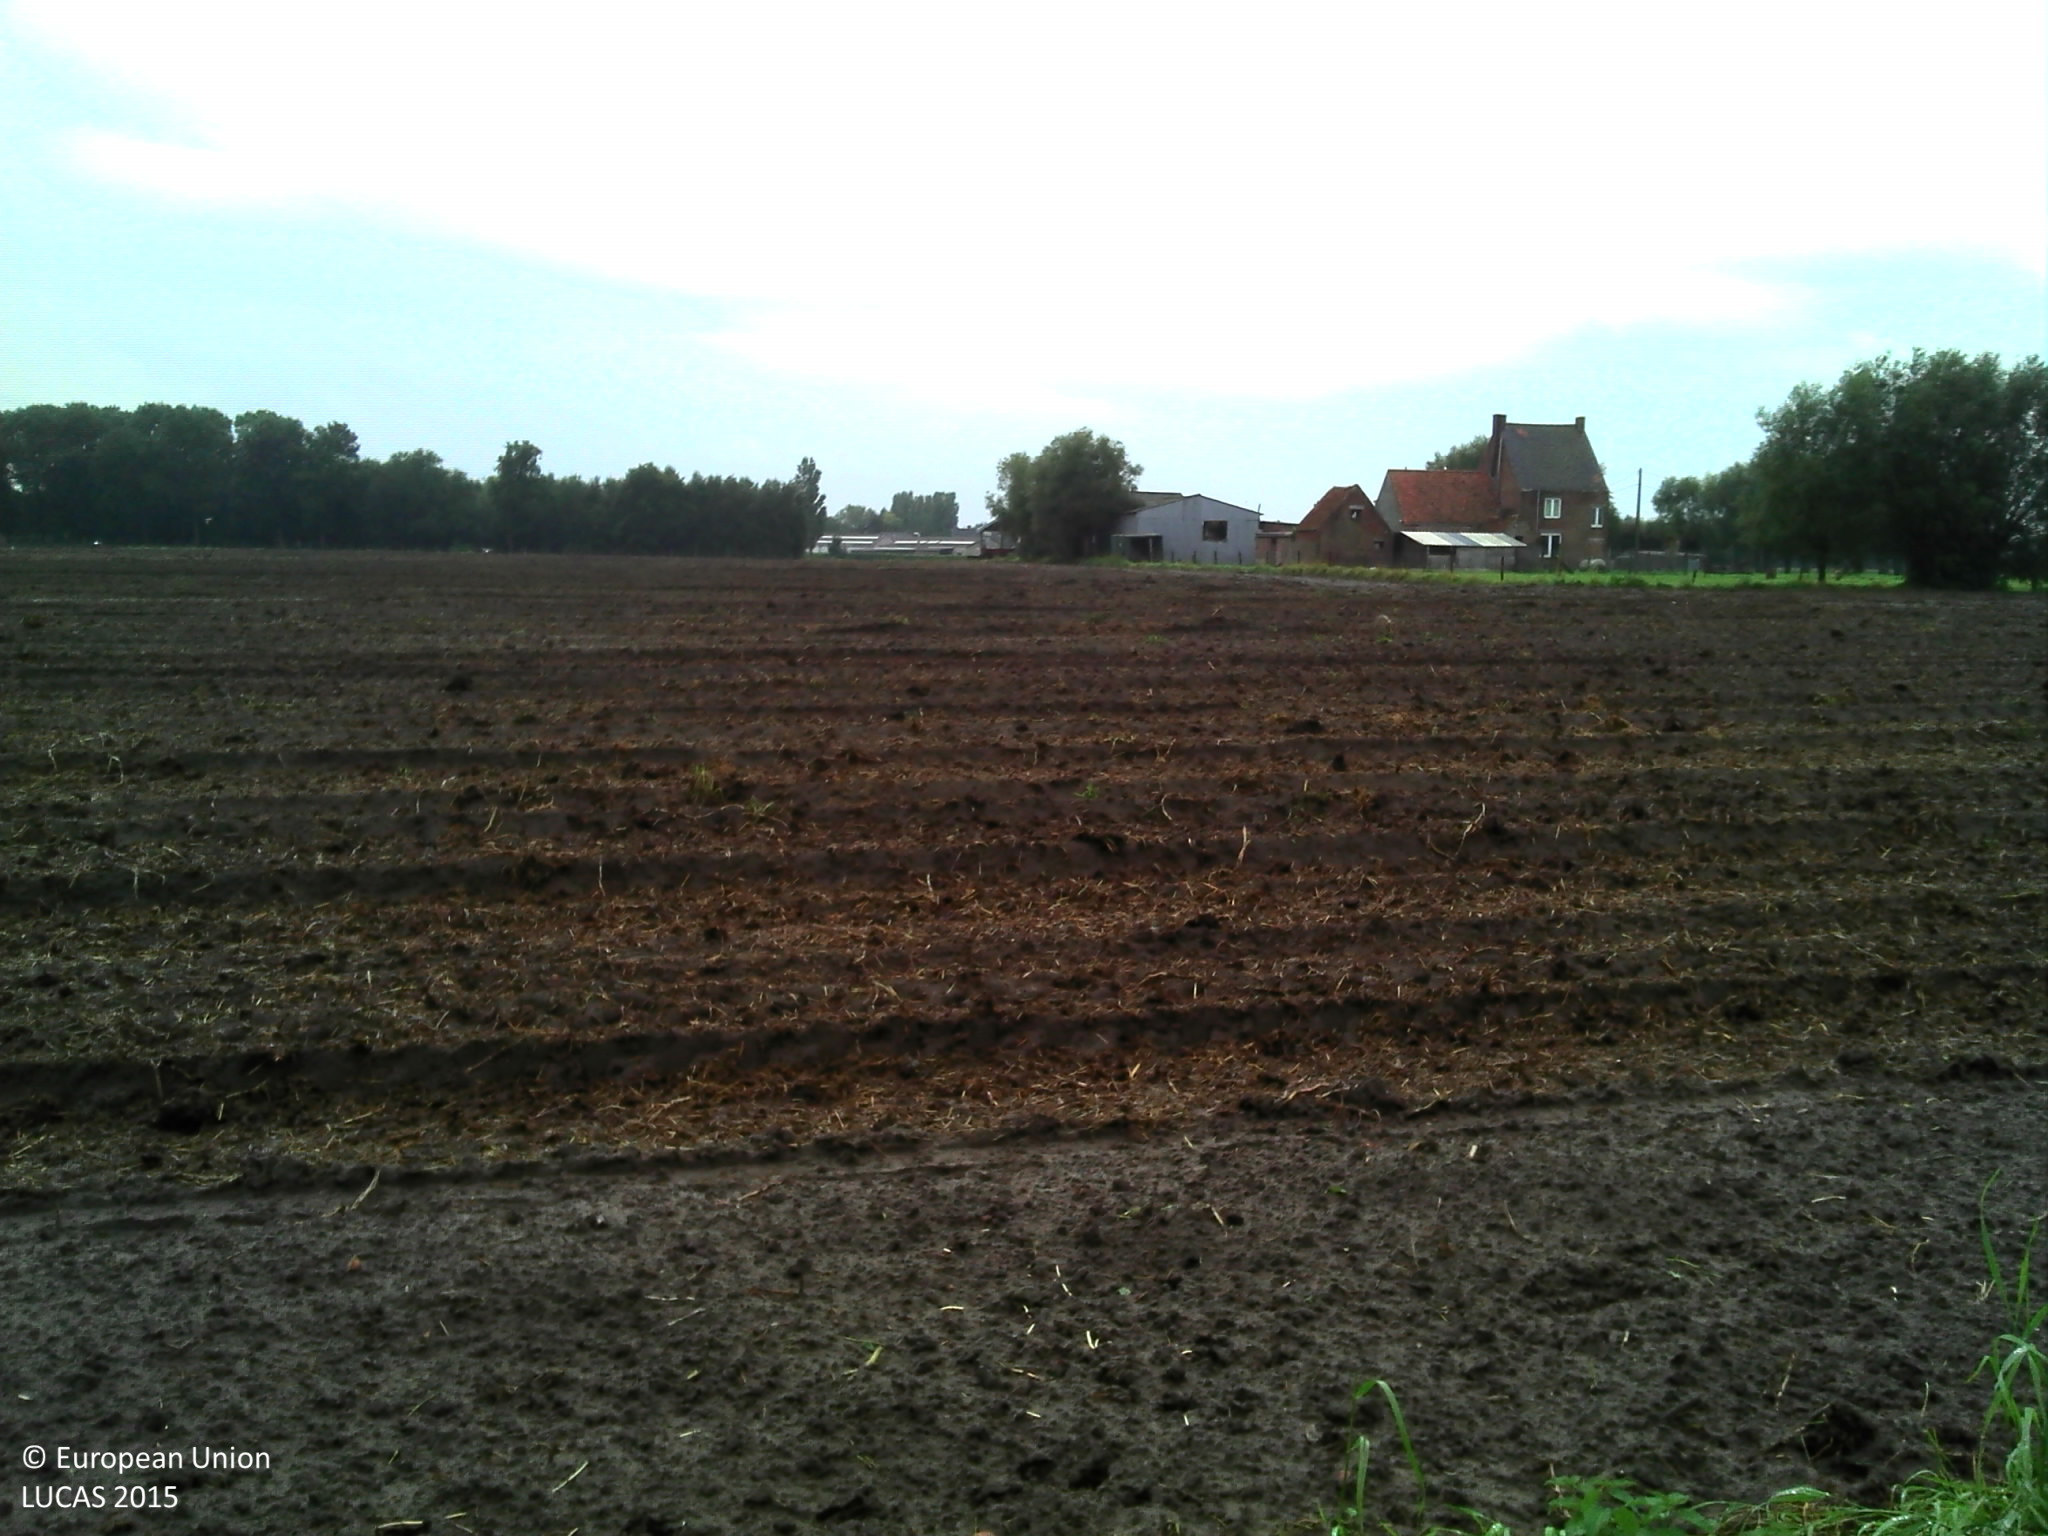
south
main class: Cropland
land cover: Maize
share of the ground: > 75 %
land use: Agriculture (excluding fallow land and kitchen gardens)
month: September
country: BE
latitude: 51.1635
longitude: 3.0546
